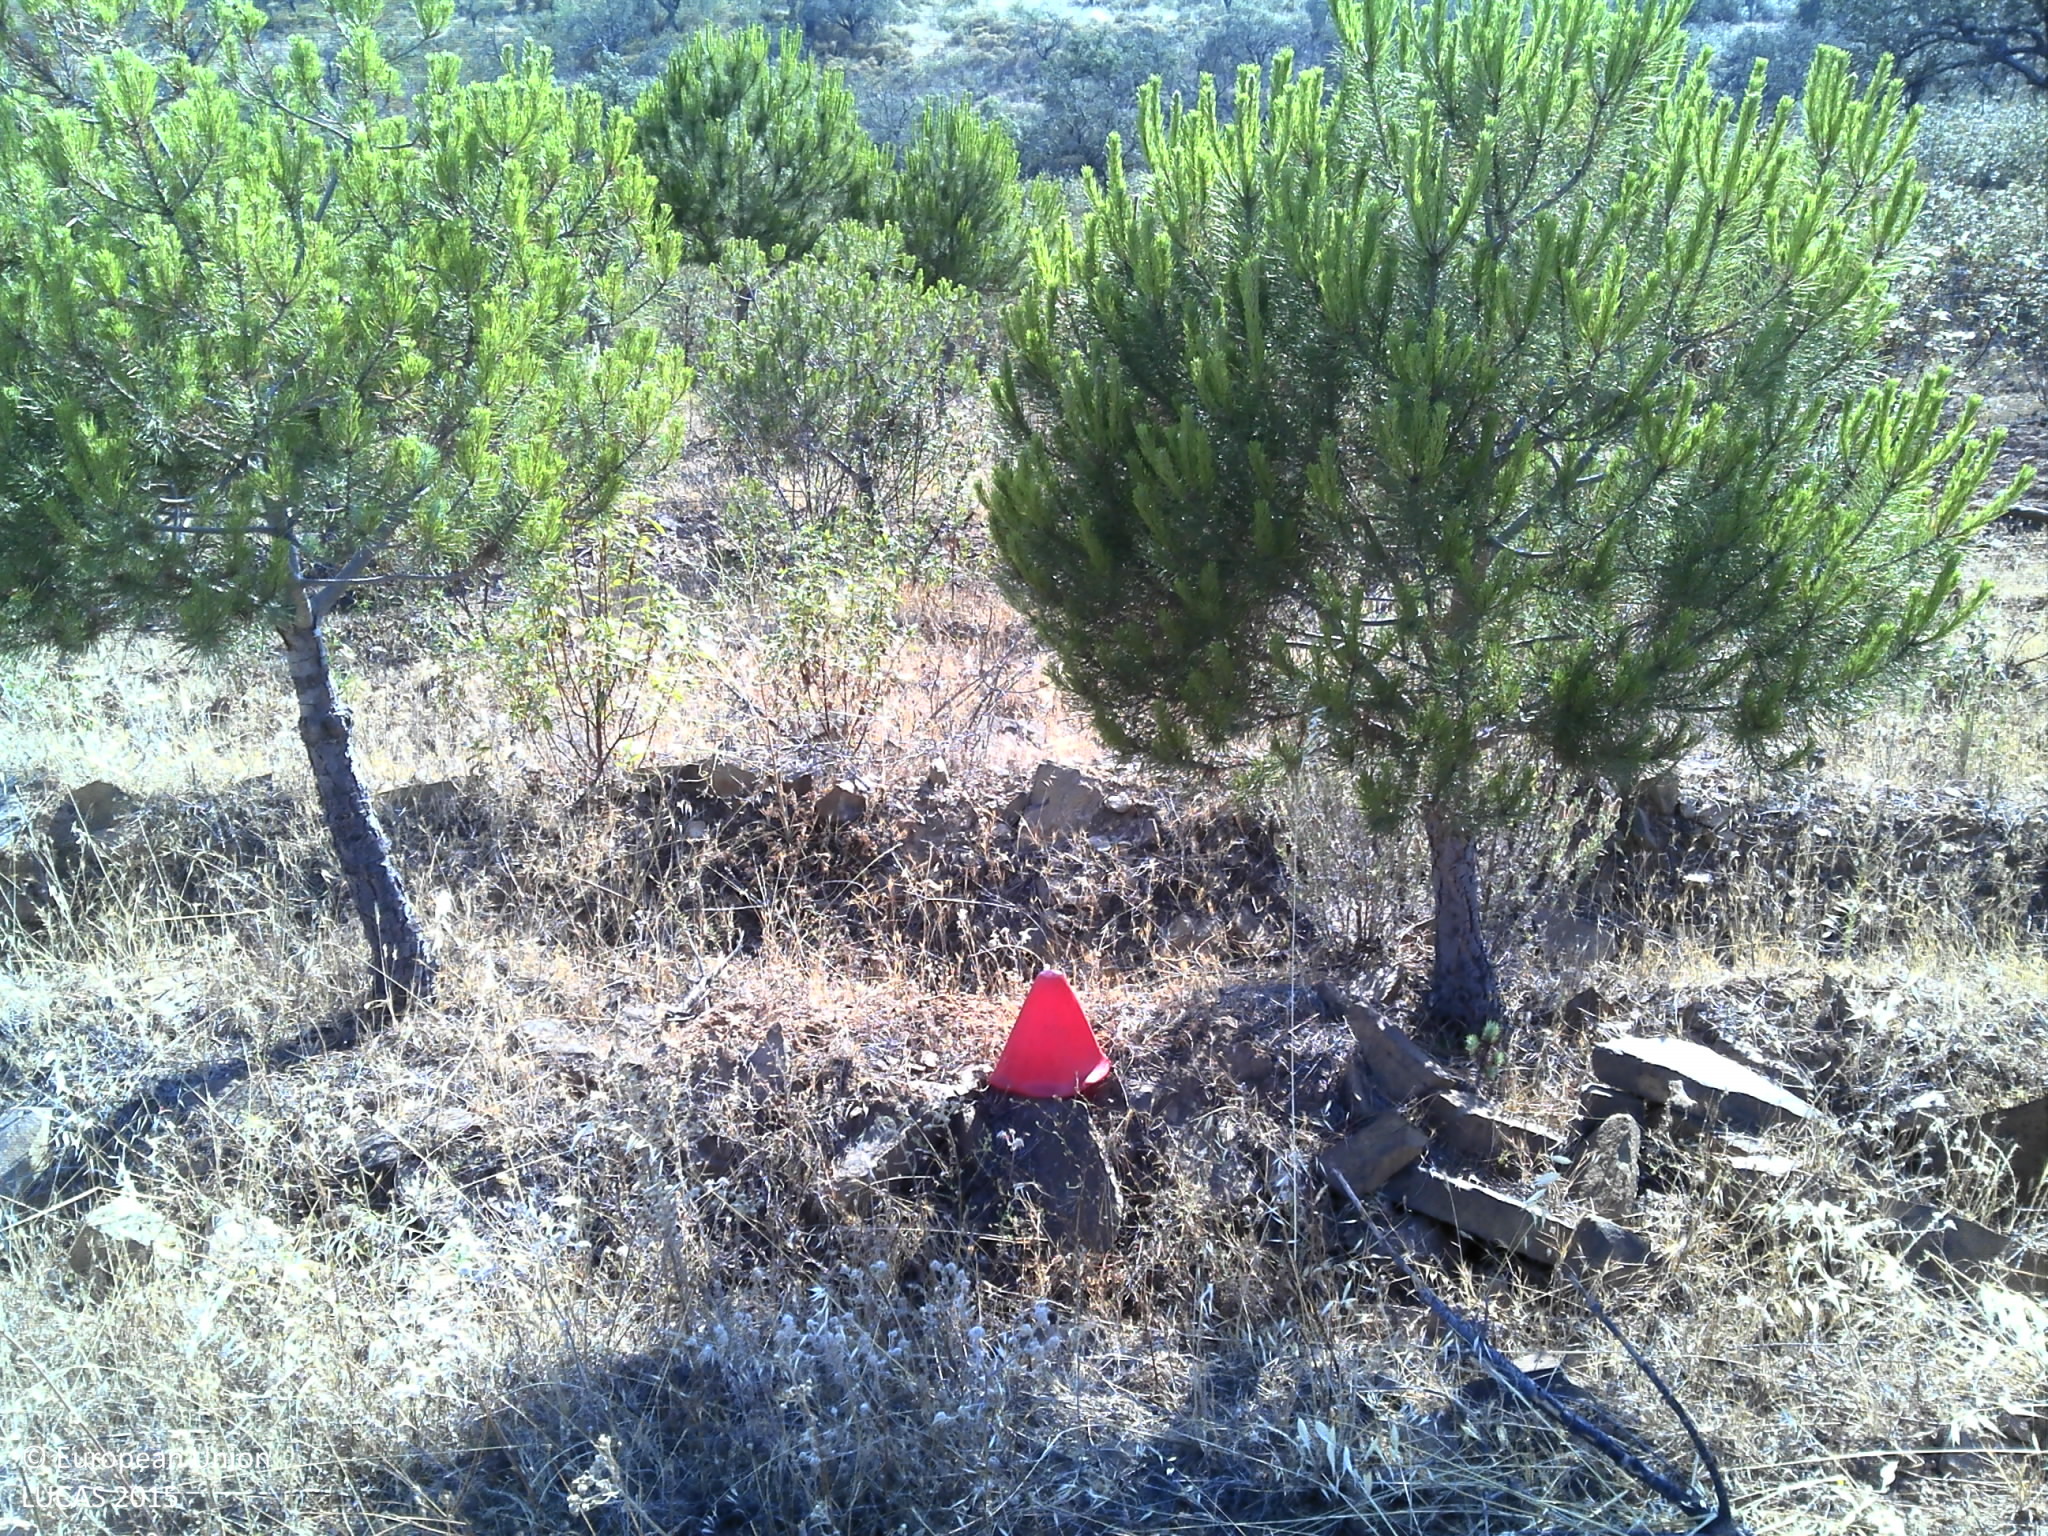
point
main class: Woodland
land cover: Pine dominated coniferous woodland
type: coniferous forest of the mediterranean region
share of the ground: 10 - 25 %
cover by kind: coniferous forest trees 65 %, broadleaved forest trees 15 %, herbaceous plants 15 %, shrubs 5 %
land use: Forestry
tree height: < 5 m
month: June
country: PT
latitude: 37.4477
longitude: -7.8647
